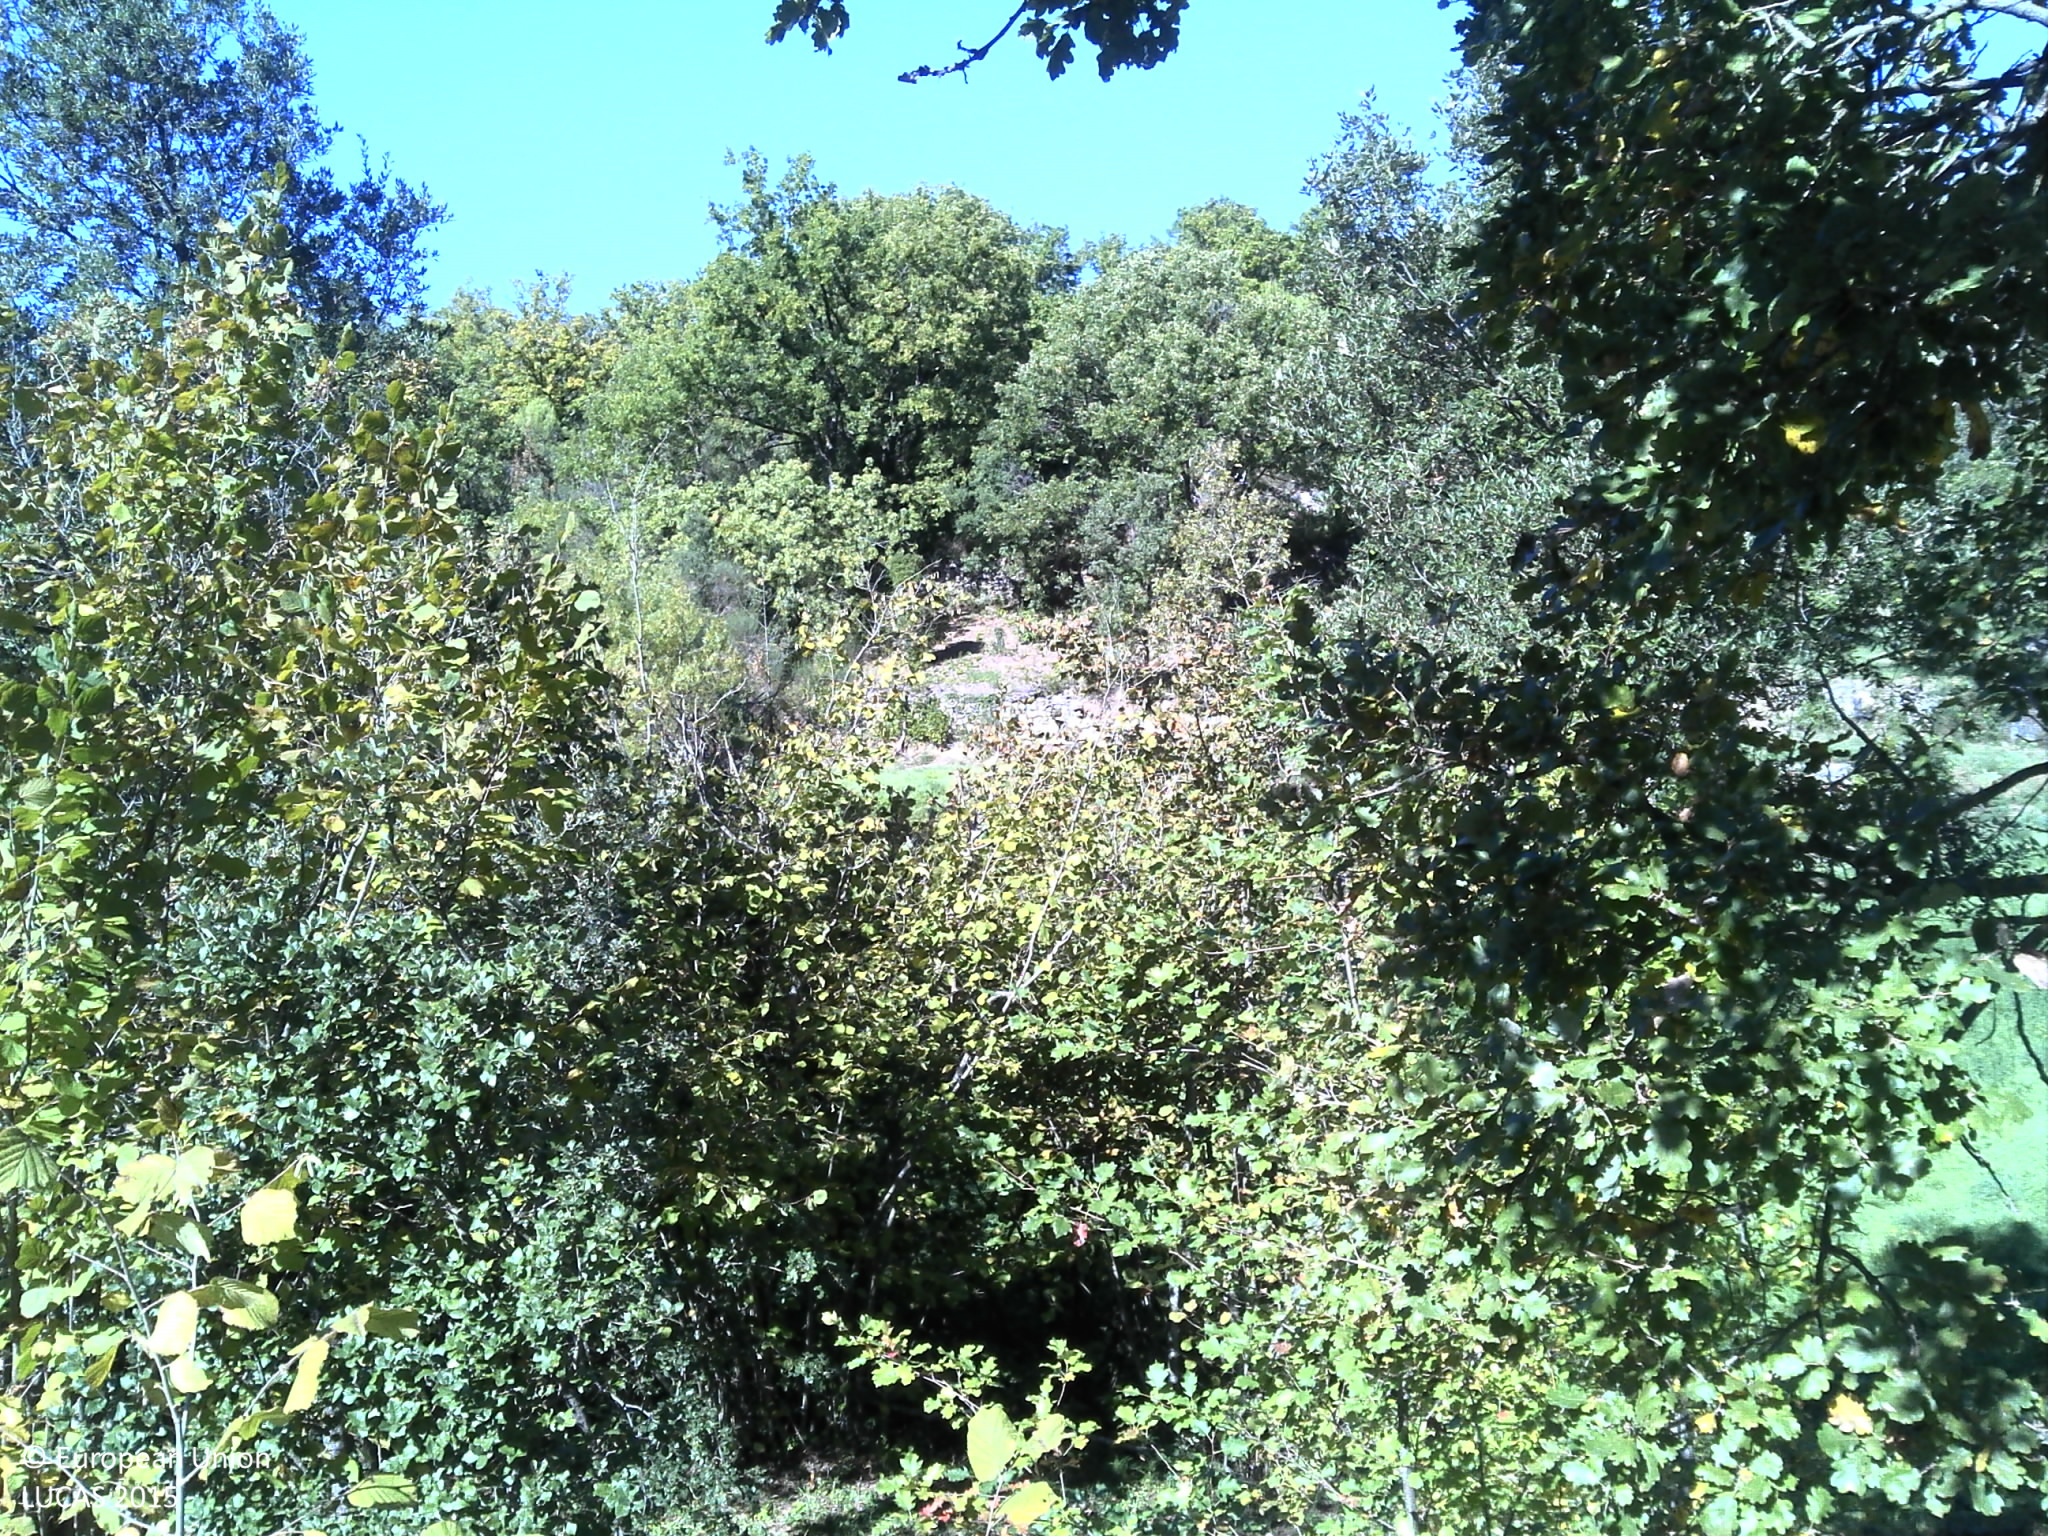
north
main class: Woodland
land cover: Broadleaved woodland
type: mesophytic deciduous forest
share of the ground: 50 - 75 %
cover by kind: broadleaved forest trees 55 %, herbaceous plants 40 %, shrubs 5 %
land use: Forestry
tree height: > 5 m
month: October
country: FR
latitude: 43.5997
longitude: 3.1577
